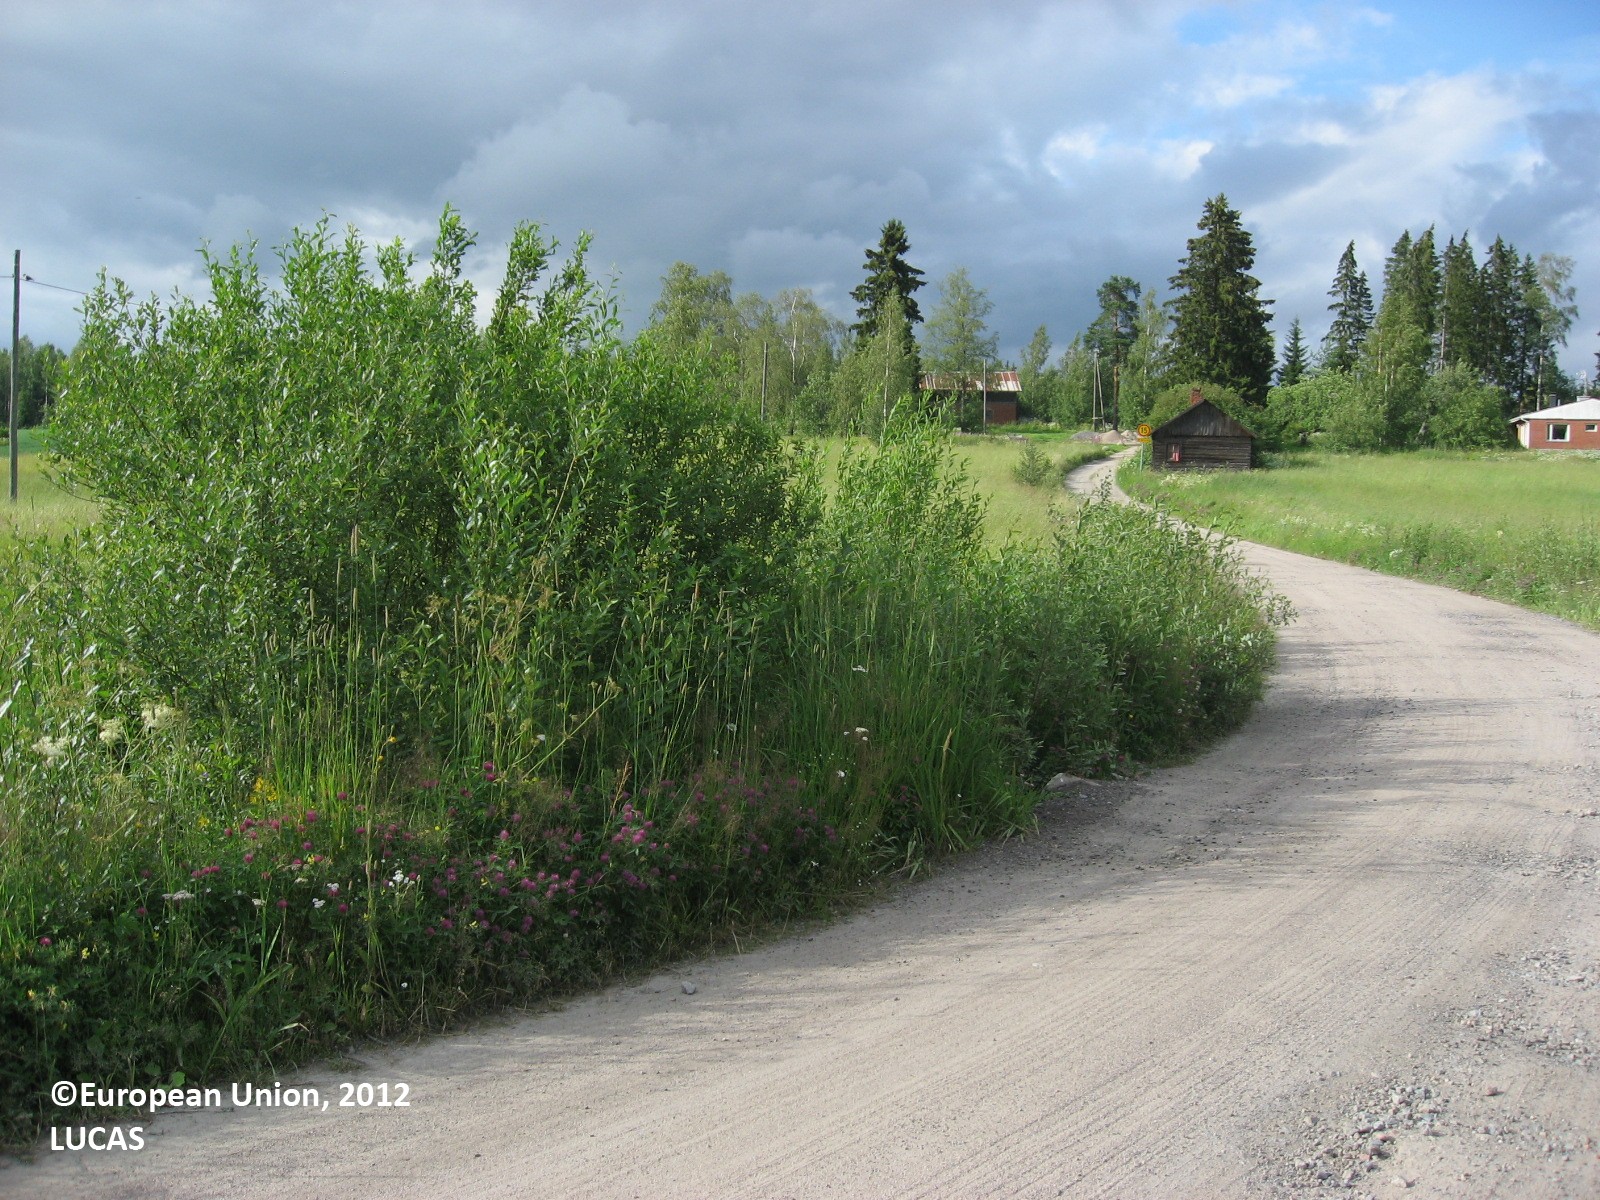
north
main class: Cropland
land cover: Temporary grasslands
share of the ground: > 75 %
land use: Agriculture (excluding fallow land and kitchen gardens)
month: July
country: FI
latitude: 61.0039
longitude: 25.7206
